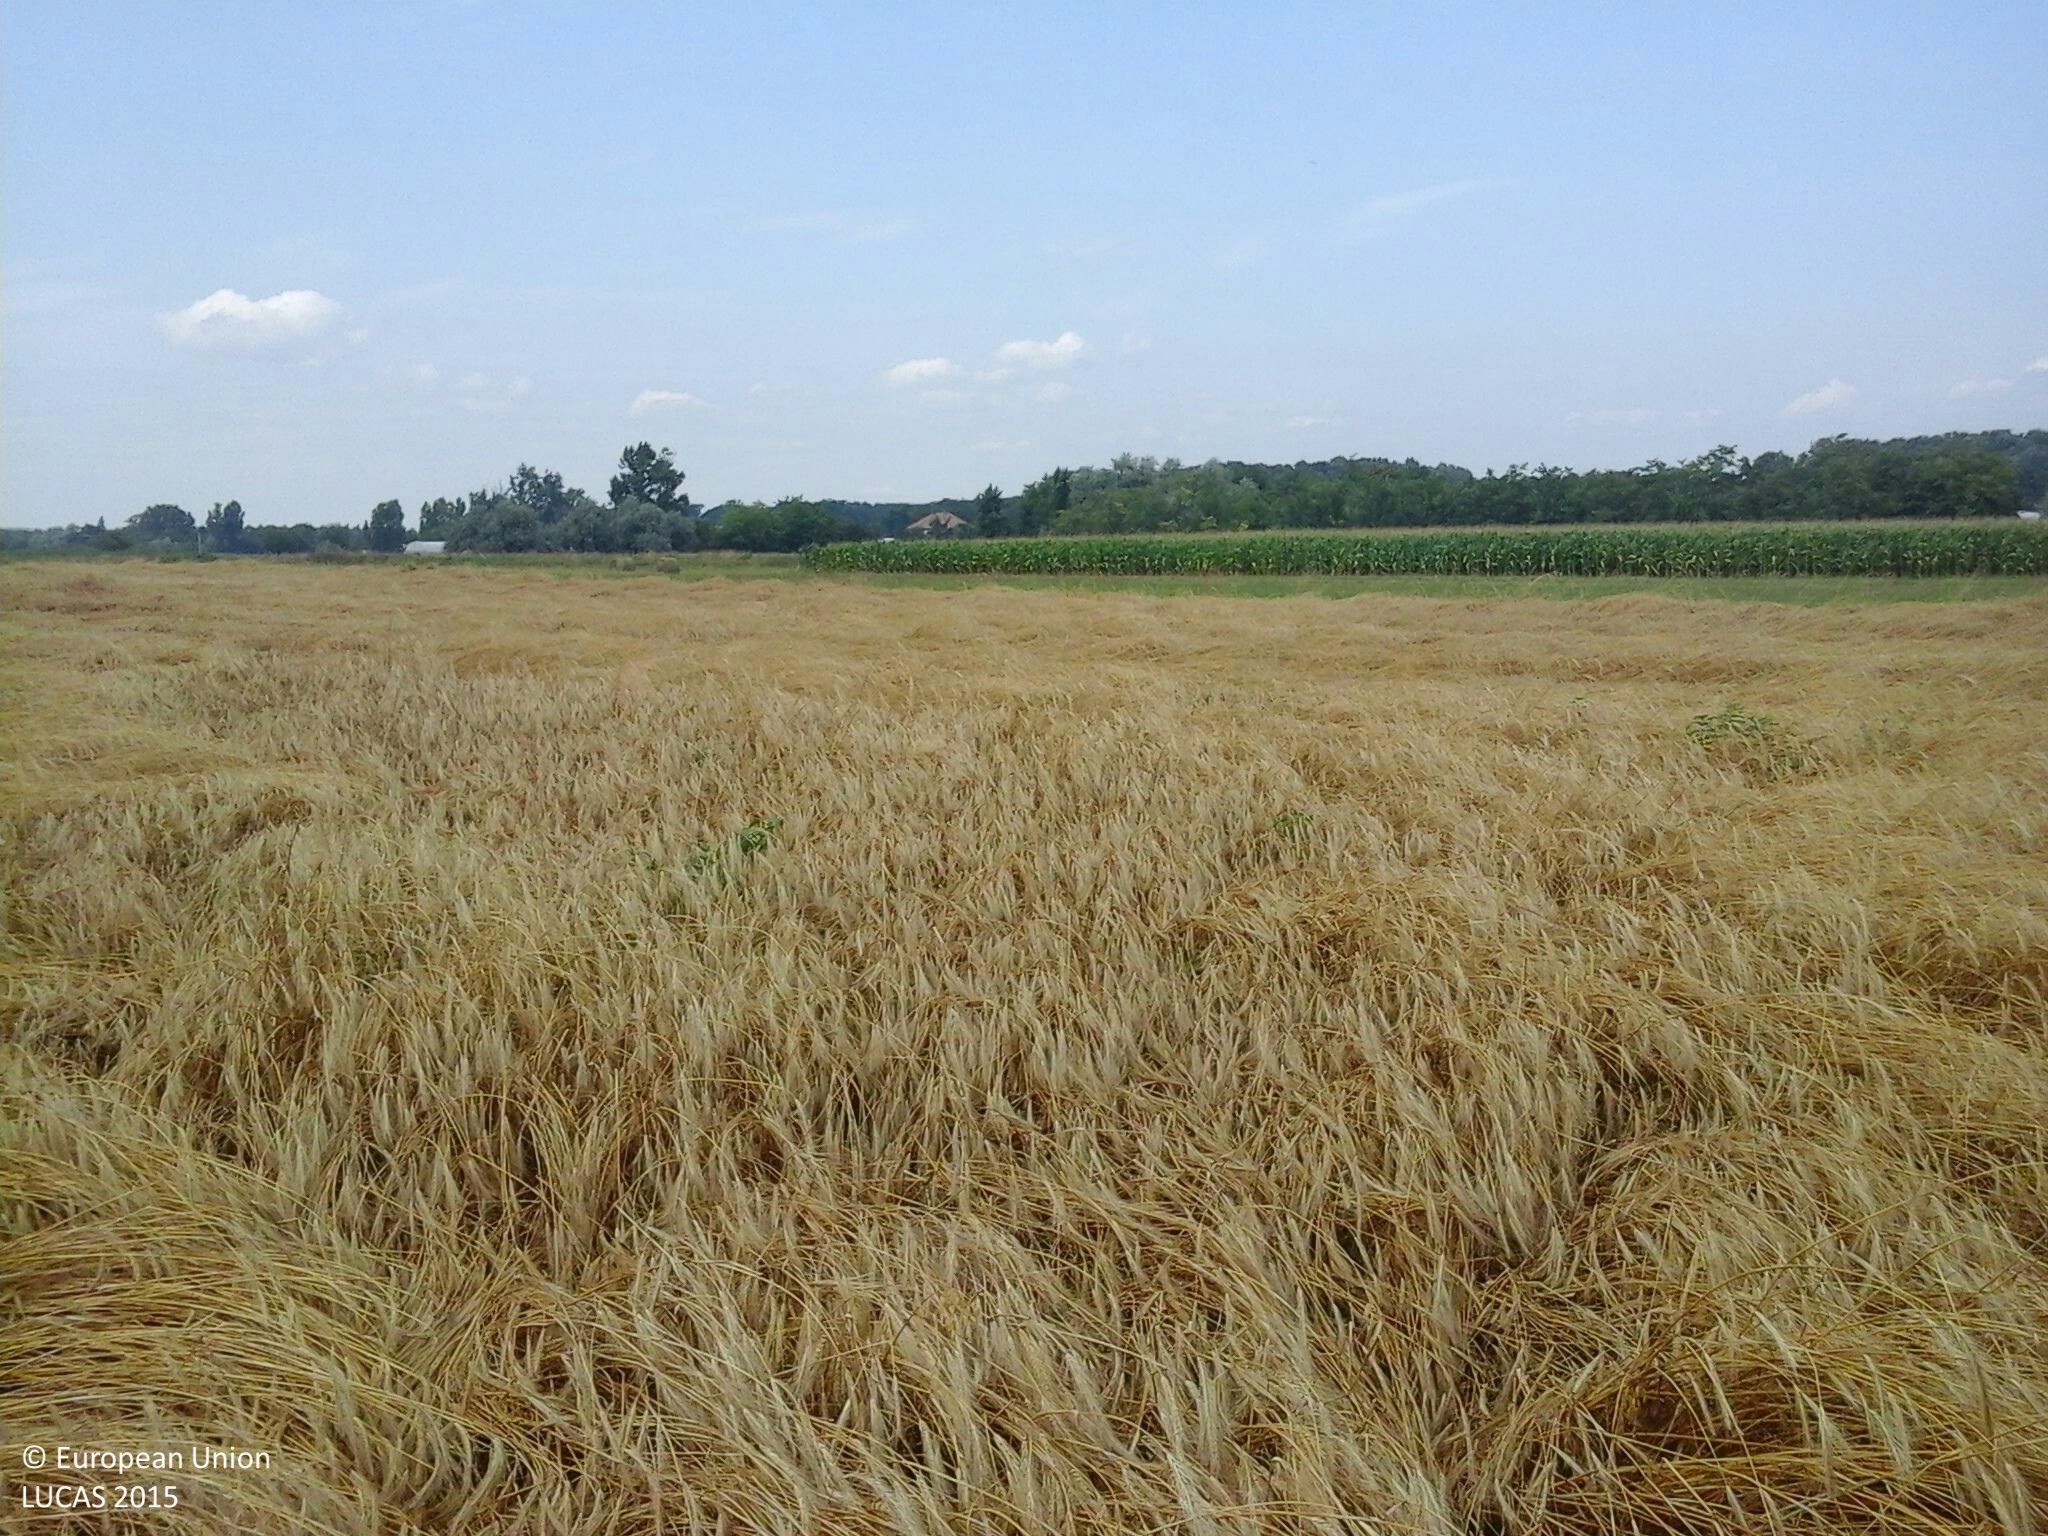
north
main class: Cropland
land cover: Triticale
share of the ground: > 75 %
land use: Agriculture (excluding fallow land and kitchen gardens)
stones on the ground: < 10 %
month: July
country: HU
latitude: 46.4409
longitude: 20.0312
